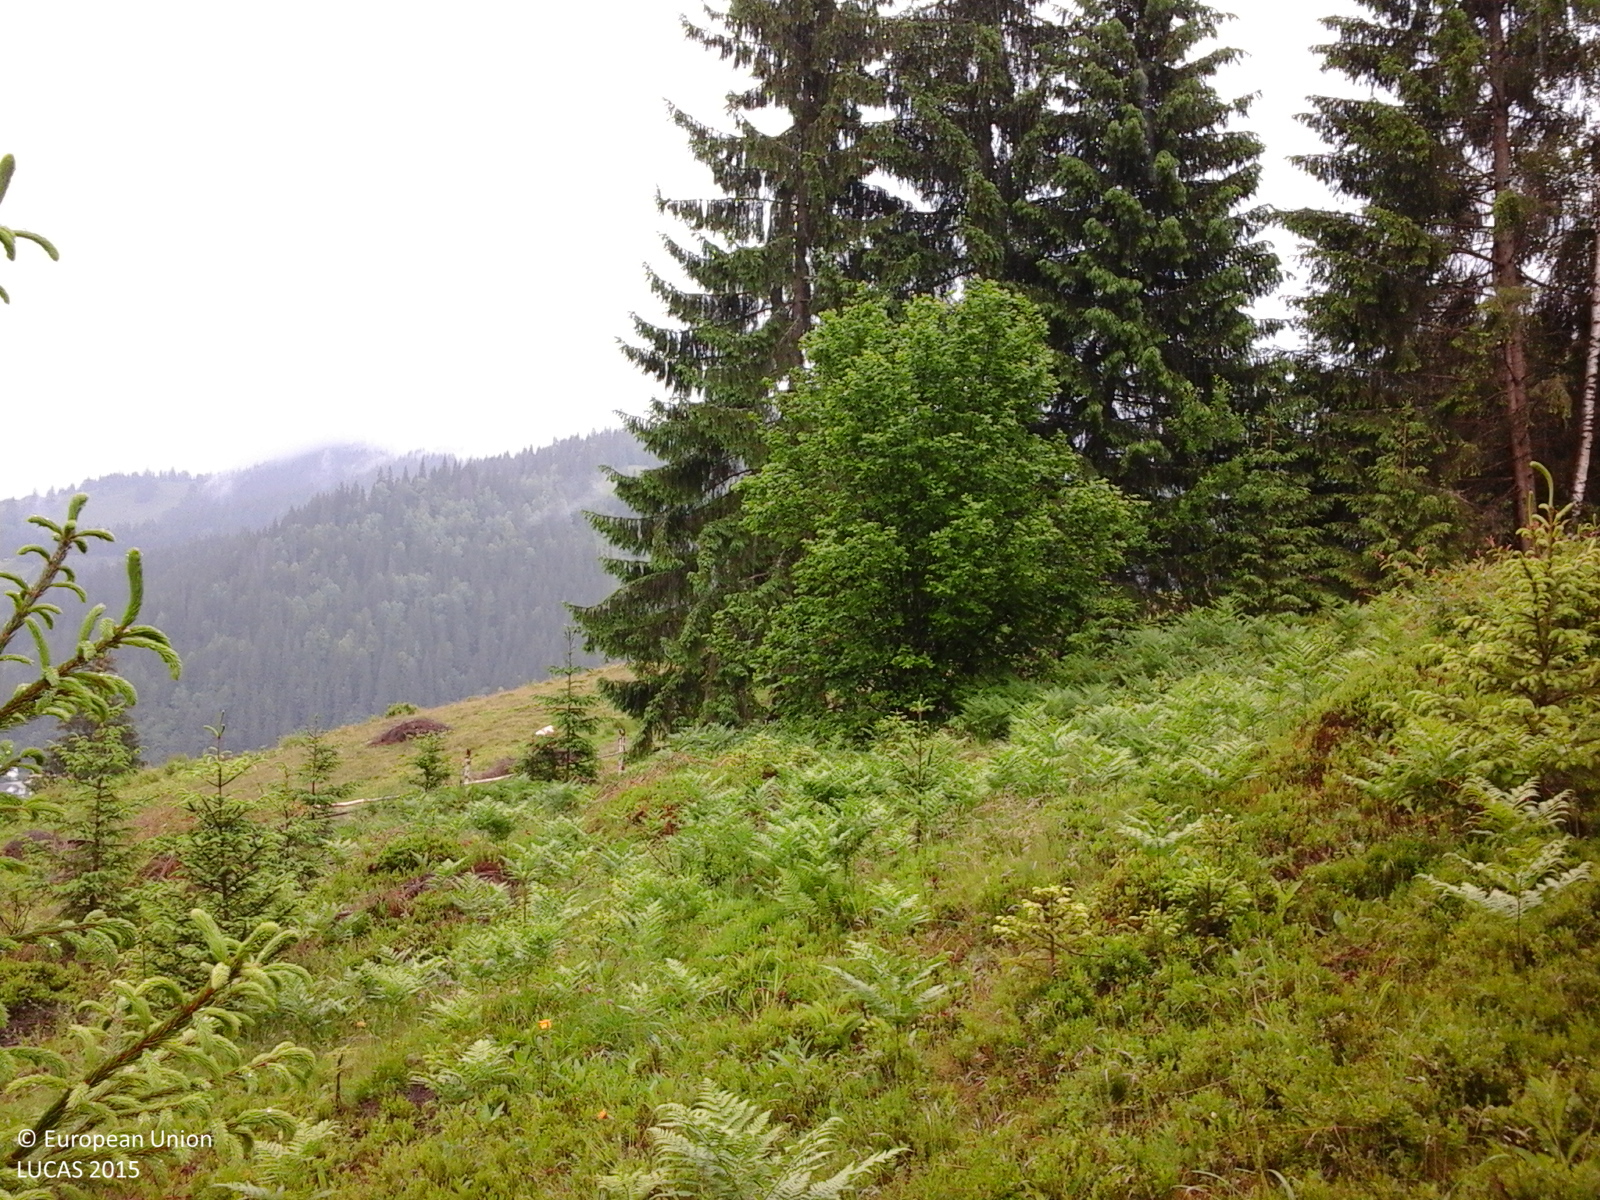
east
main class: Grassland
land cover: Grassland with sparse tree/shrub cover
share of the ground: > 75 %
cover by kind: herbaceous plants 85 %, shrubs 10 %, coniferous forest trees 5 %
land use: Agriculture (excluding fallow land and kitchen gardens)
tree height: > 5 m
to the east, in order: Grassland with sparse tree/shrub cover; Spruce dominated coniferous woodland; Fences; Grassland without tree/shrub cover; Single bushes/trees; Grassland without tree/shrub cover; Single bushes/trees; Grassland without tree/shrub cover; Spruce dominated coniferous woodland; Grassland without tree/shrub cover; Fences; Spruce dominated coniferous woodland
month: June
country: RO
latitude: 47.5641
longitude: 25.3311
